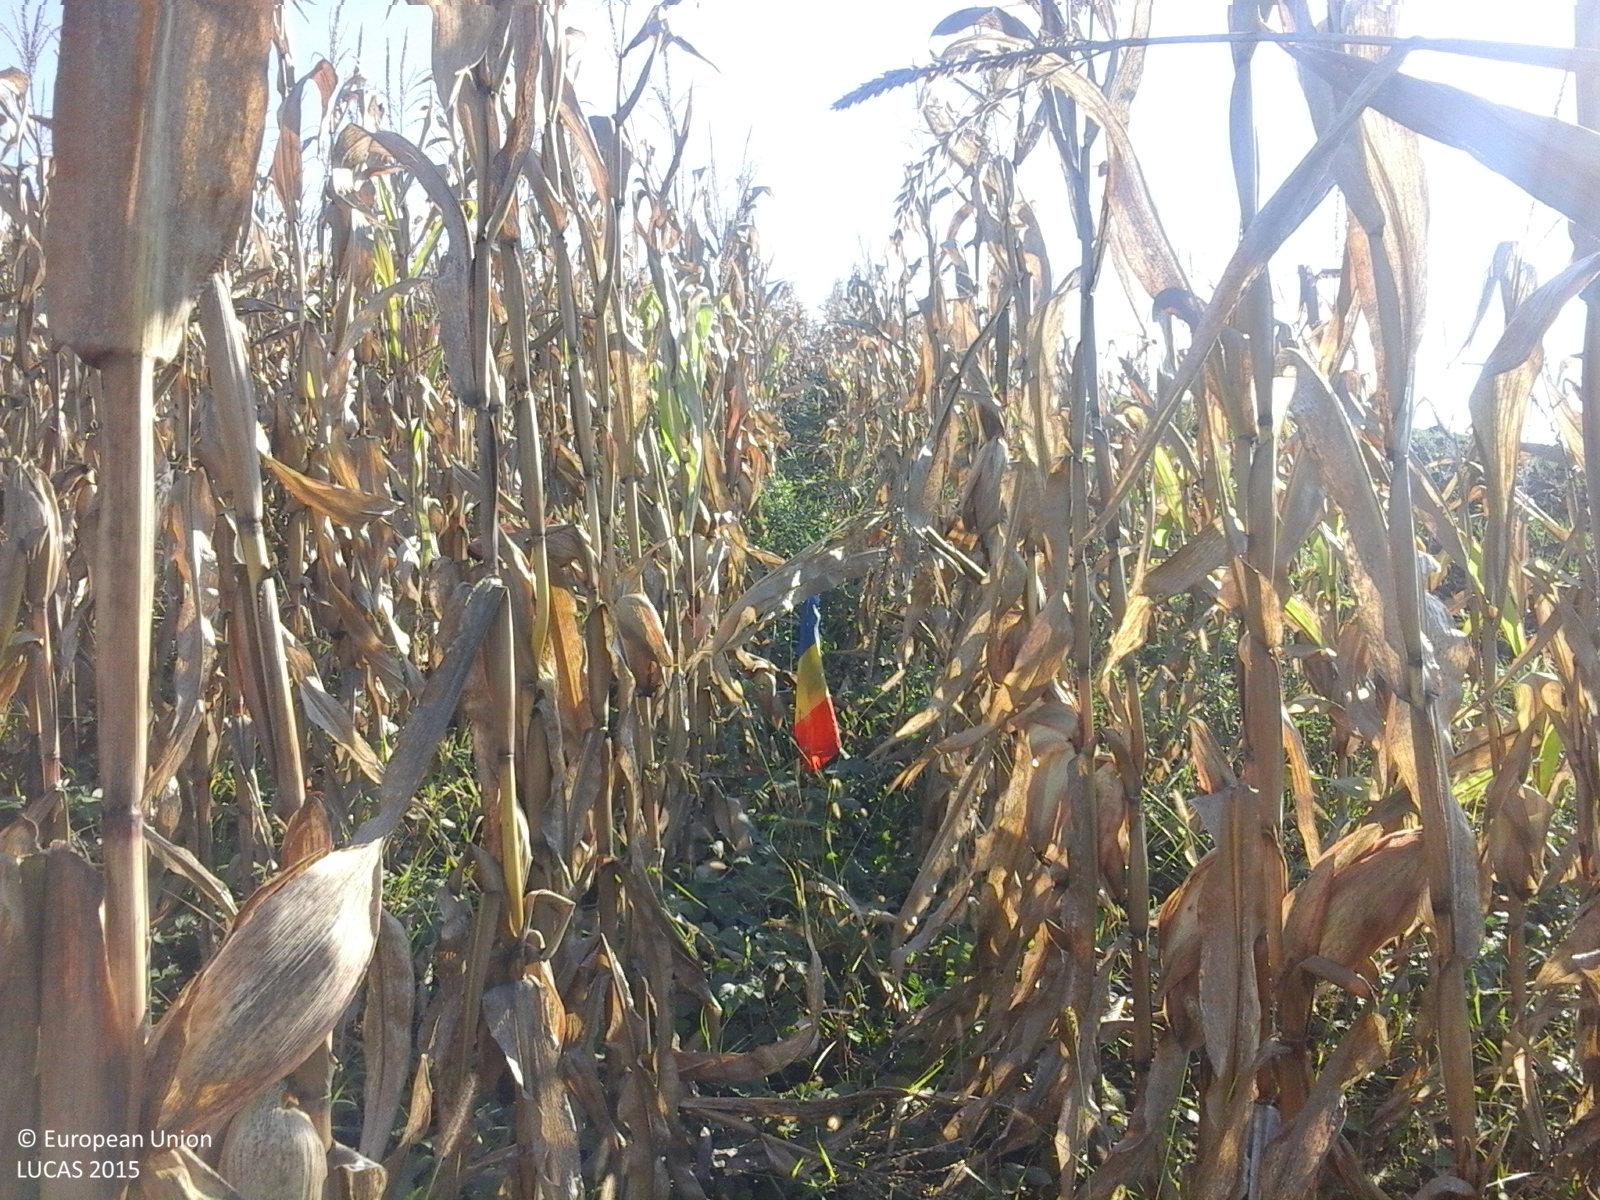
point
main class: Cropland
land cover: Maize
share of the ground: > 75 %
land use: Agriculture (excluding fallow land and kitchen gardens)
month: October
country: RO
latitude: 46.2262
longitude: 23.8809
